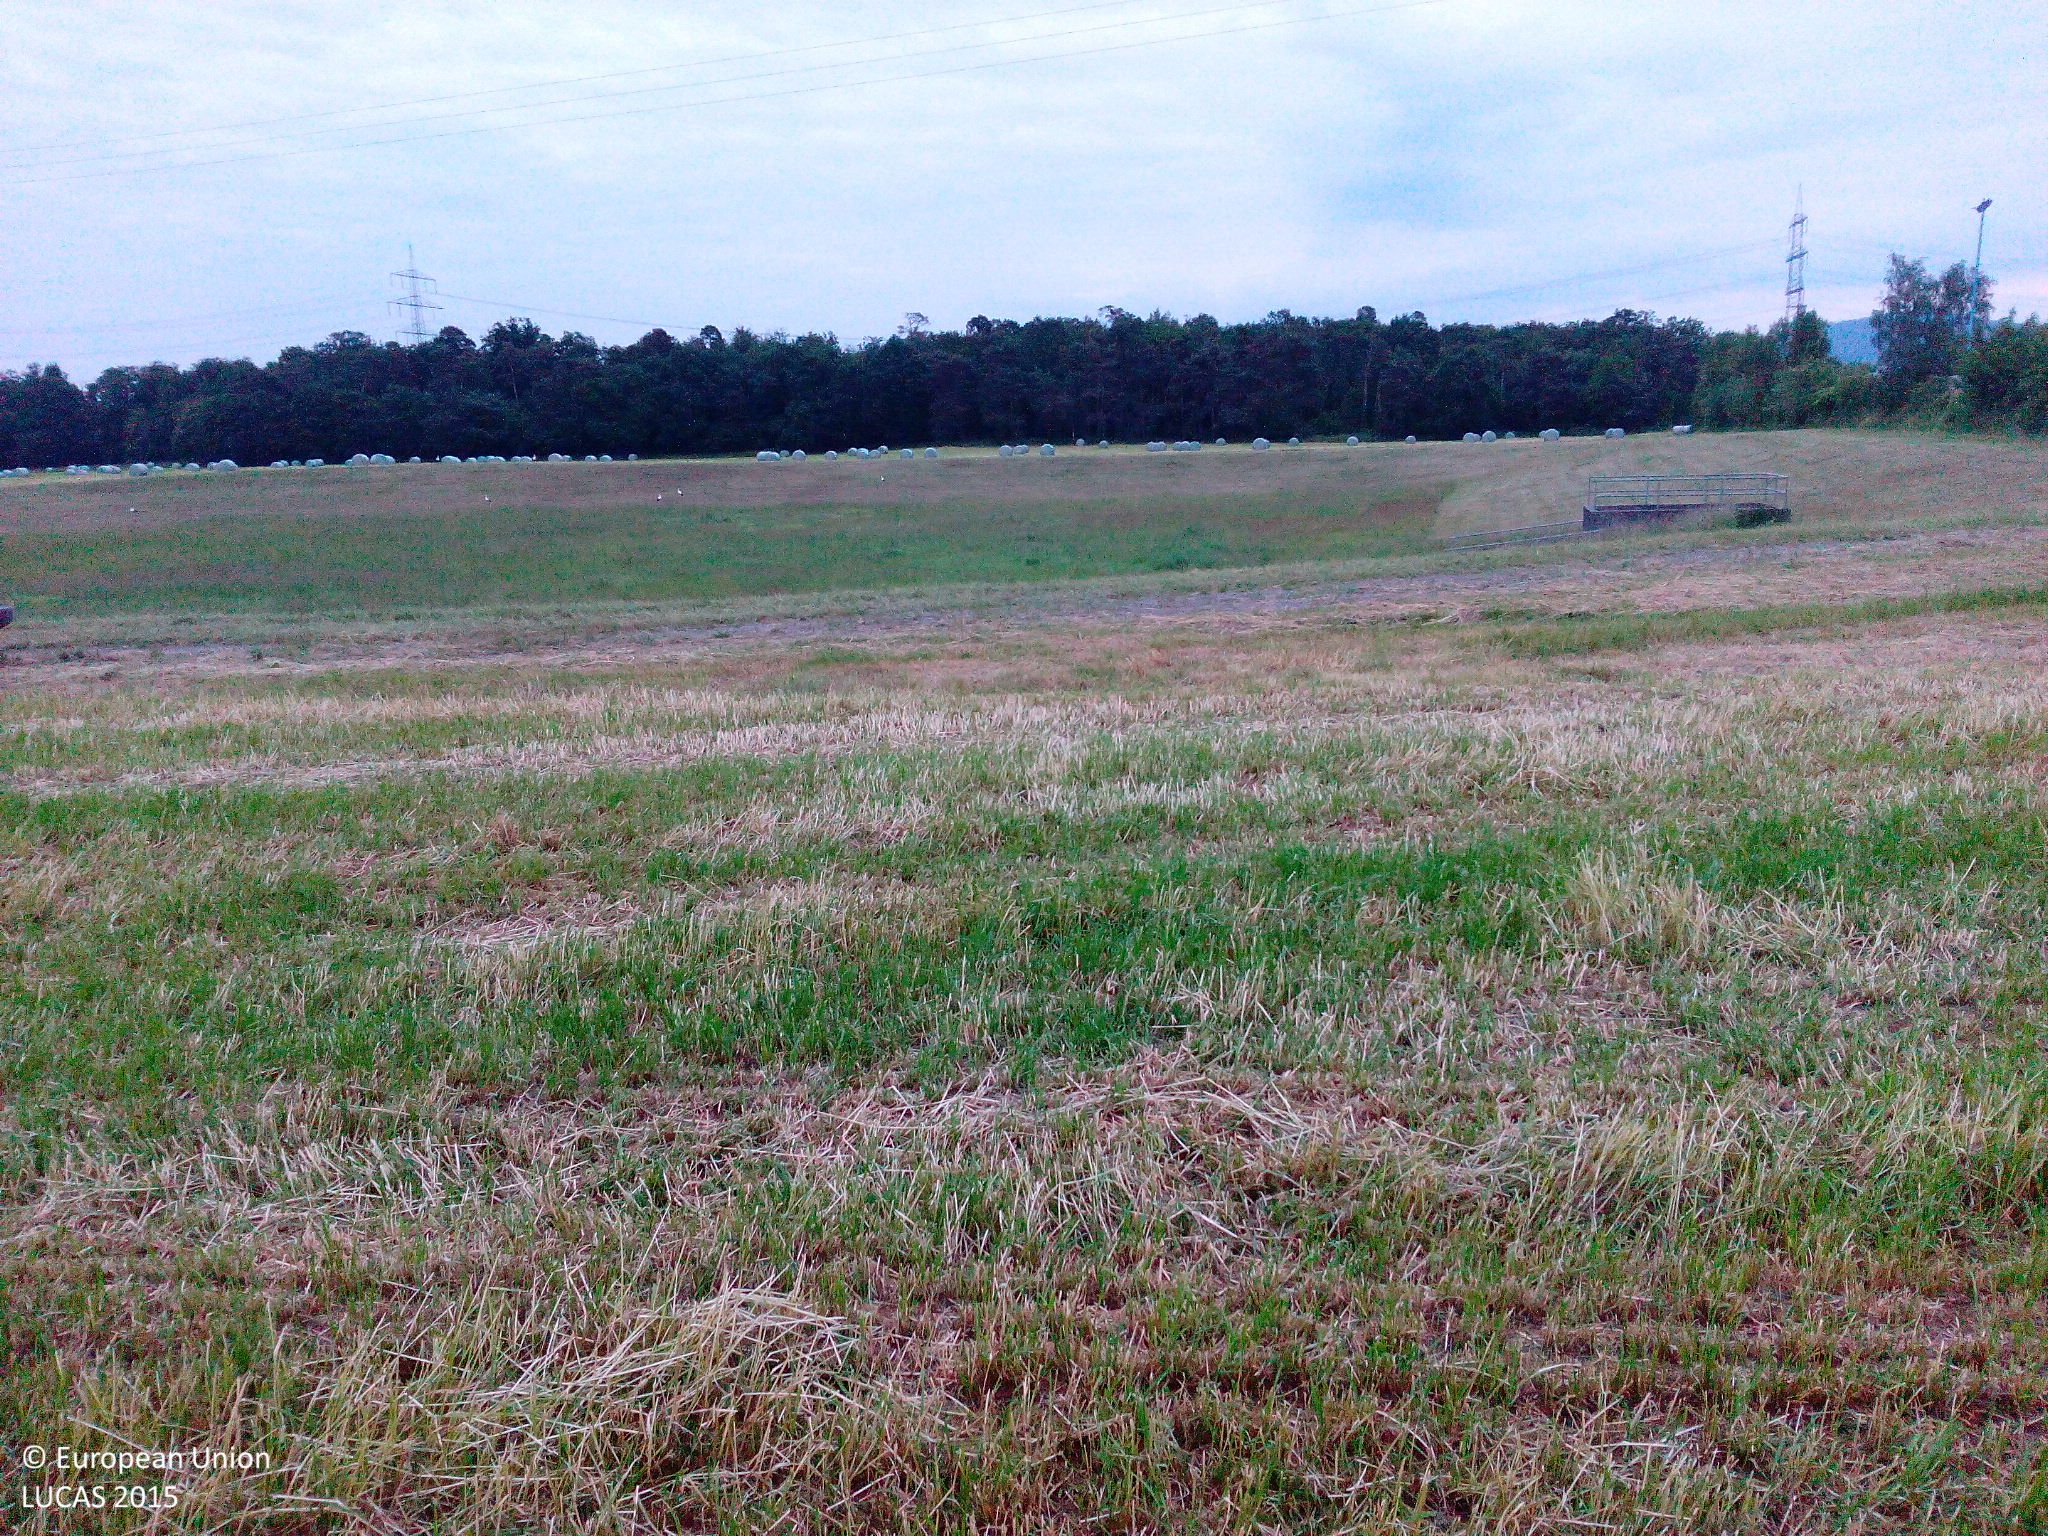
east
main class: Cropland
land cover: Temporary grasslands
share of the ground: 10 - 25 %
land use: Agriculture (excluding fallow land and kitchen gardens)
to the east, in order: Temporary grasslands; Tracks; Grassland without tree/shrub cover
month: May
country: DE
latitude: 48.8201
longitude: 8.1620
